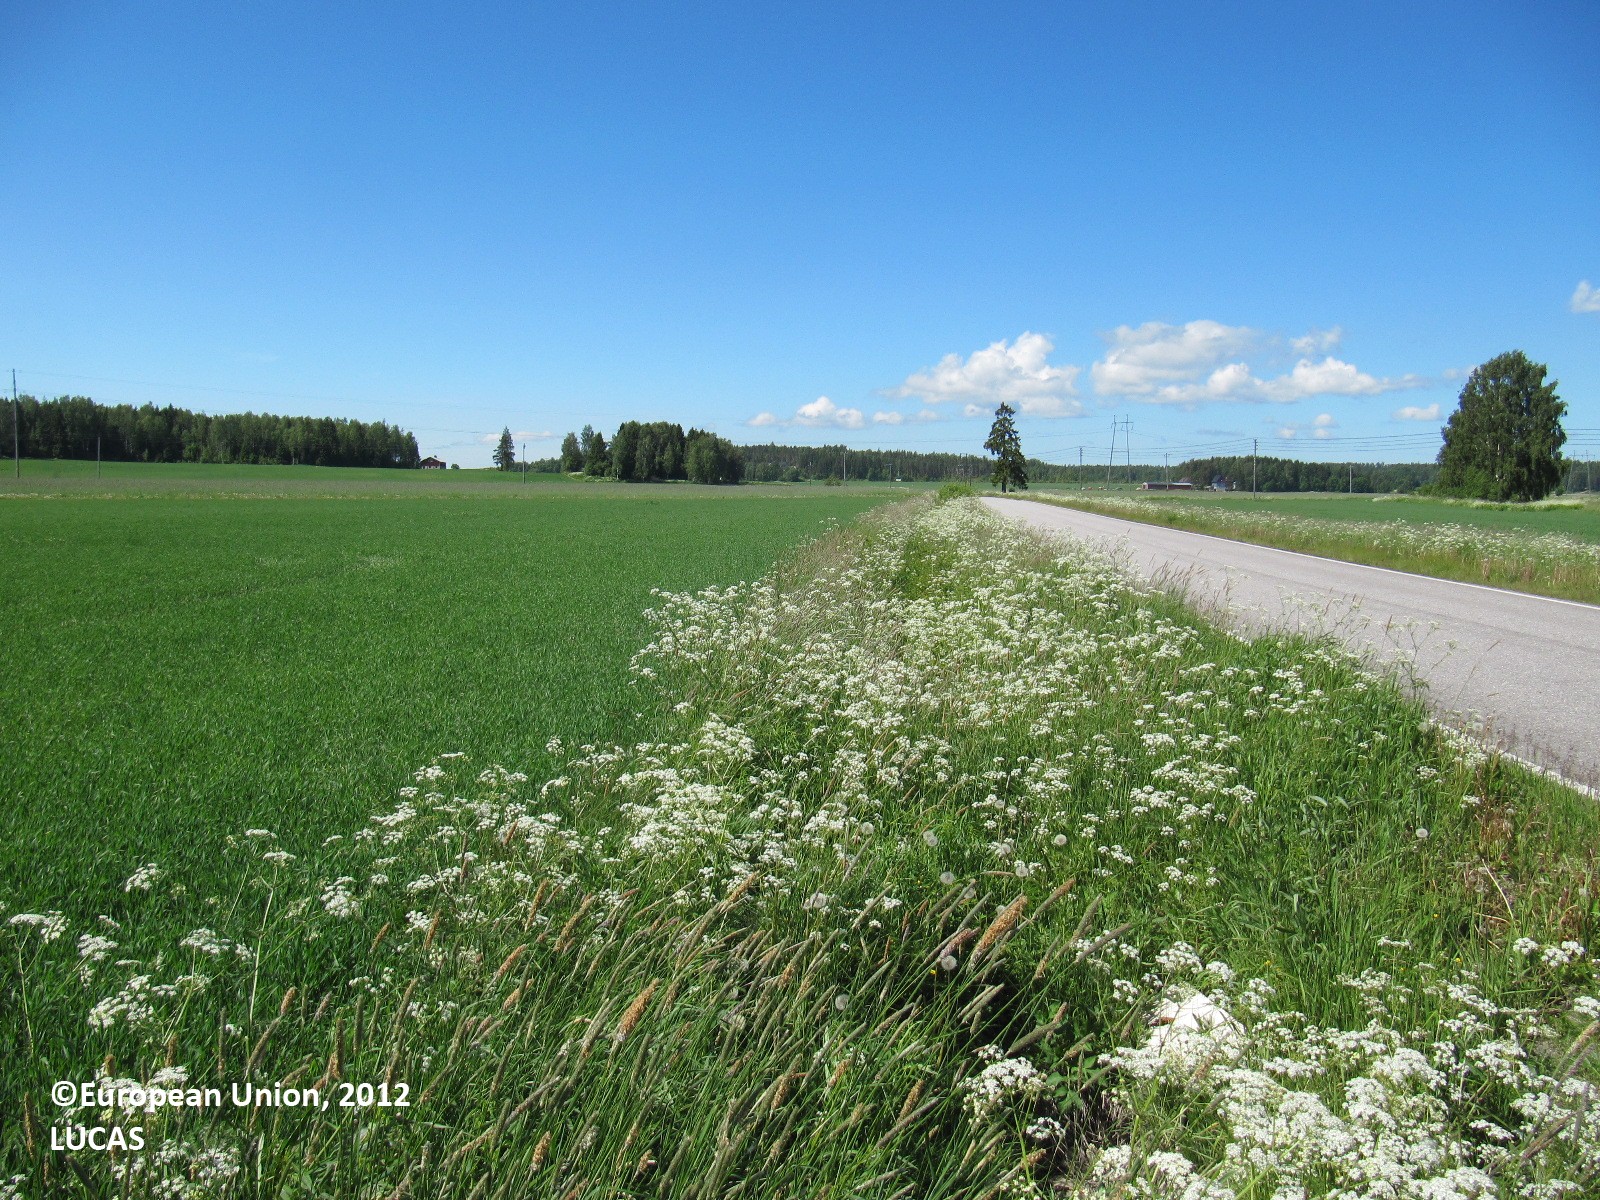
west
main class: Cropland
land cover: Common wheat
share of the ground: > 75 %
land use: Agriculture (excluding fallow land and kitchen gardens)
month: June
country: FI
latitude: 60.1144
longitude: 24.2273
